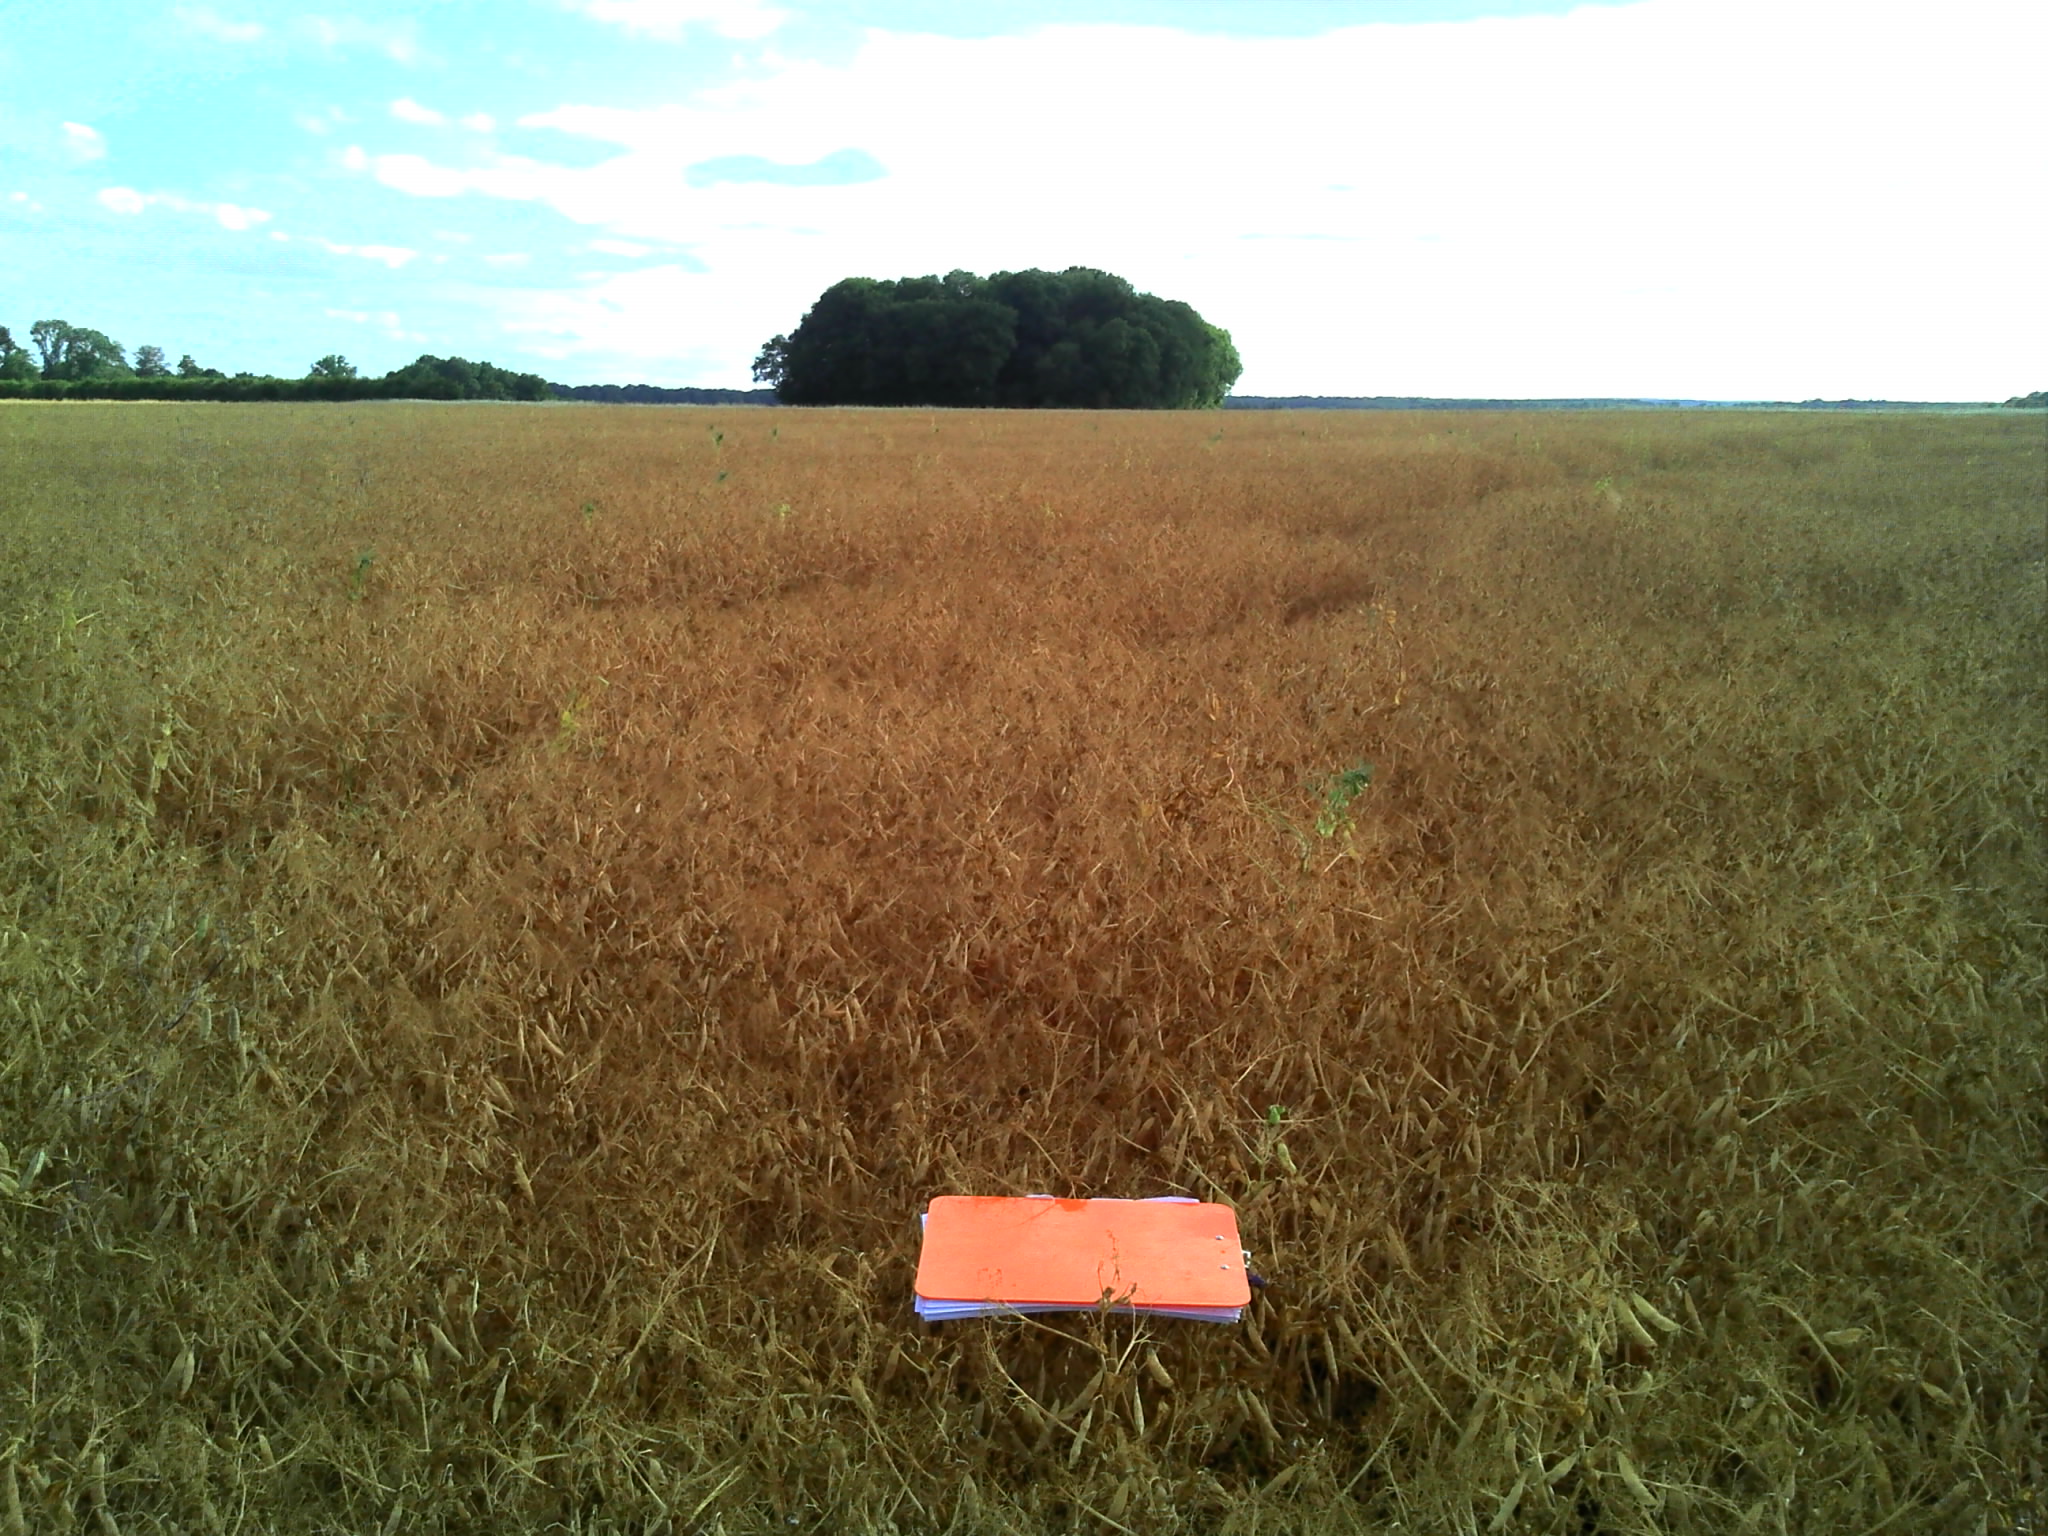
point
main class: Cropland
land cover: Dry pulses
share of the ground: > 75 %
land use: Agriculture (excluding fallow land and kitchen gardens)
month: July
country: FR
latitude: 48.6876
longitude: 0.7808
